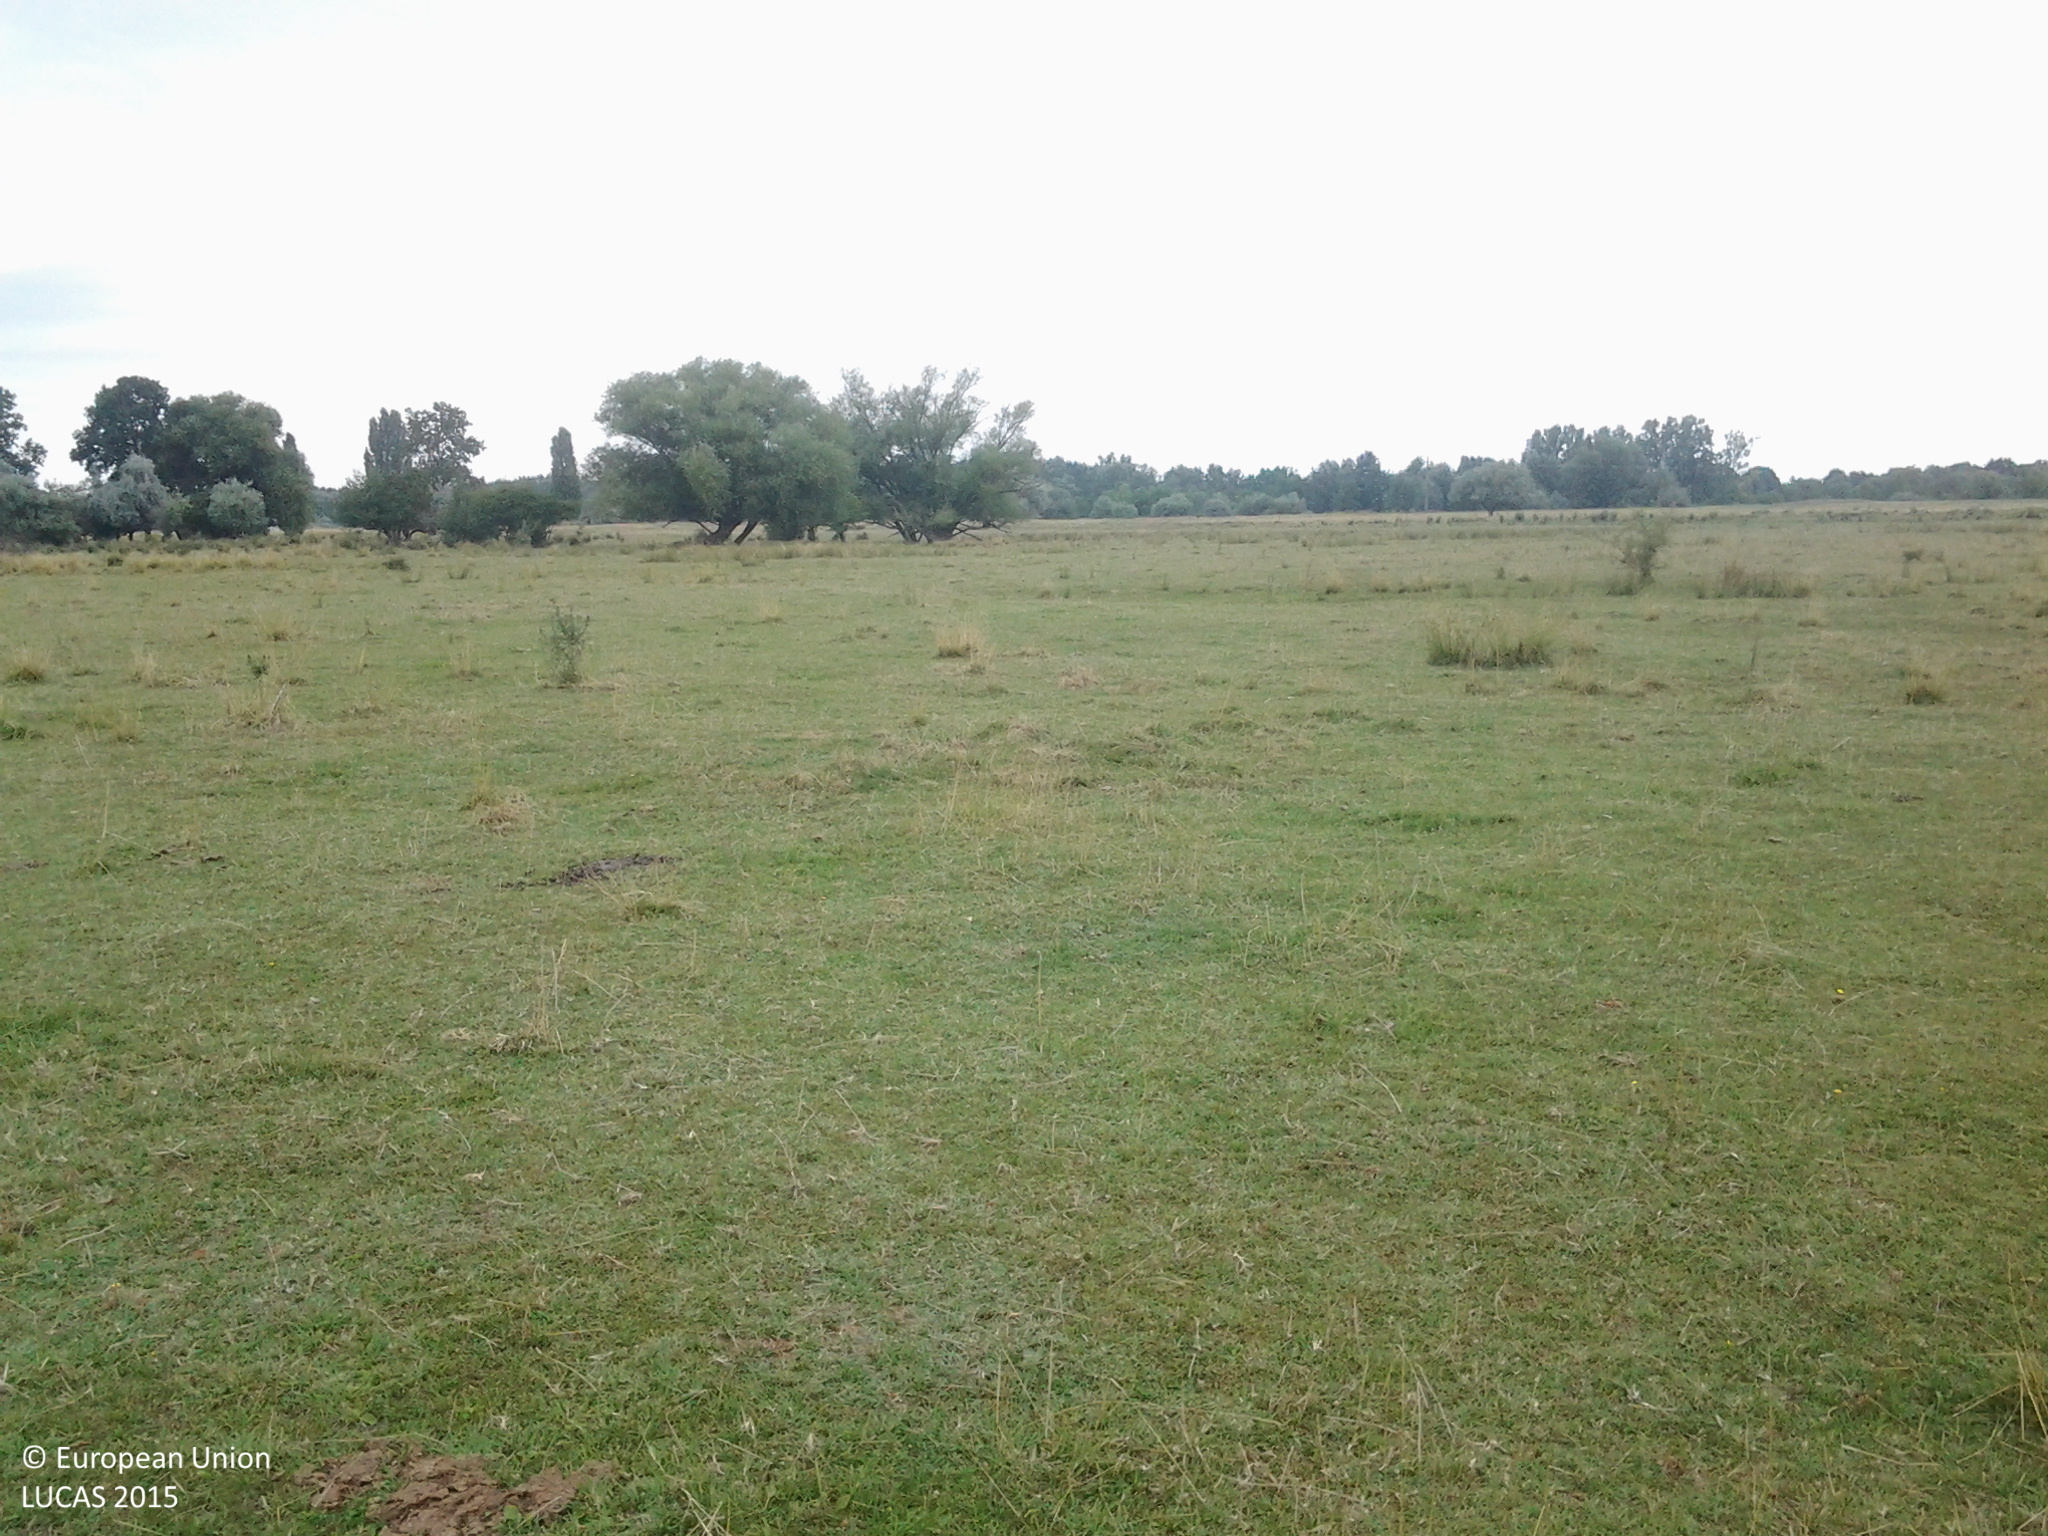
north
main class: Grassland
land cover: Grassland without tree/shrub cover
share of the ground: > 75 %
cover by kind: herbaceous plants 100 %
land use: Agriculture (excluding fallow land and kitchen gardens)
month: July
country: HU
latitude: 46.6381
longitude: 19.2518
